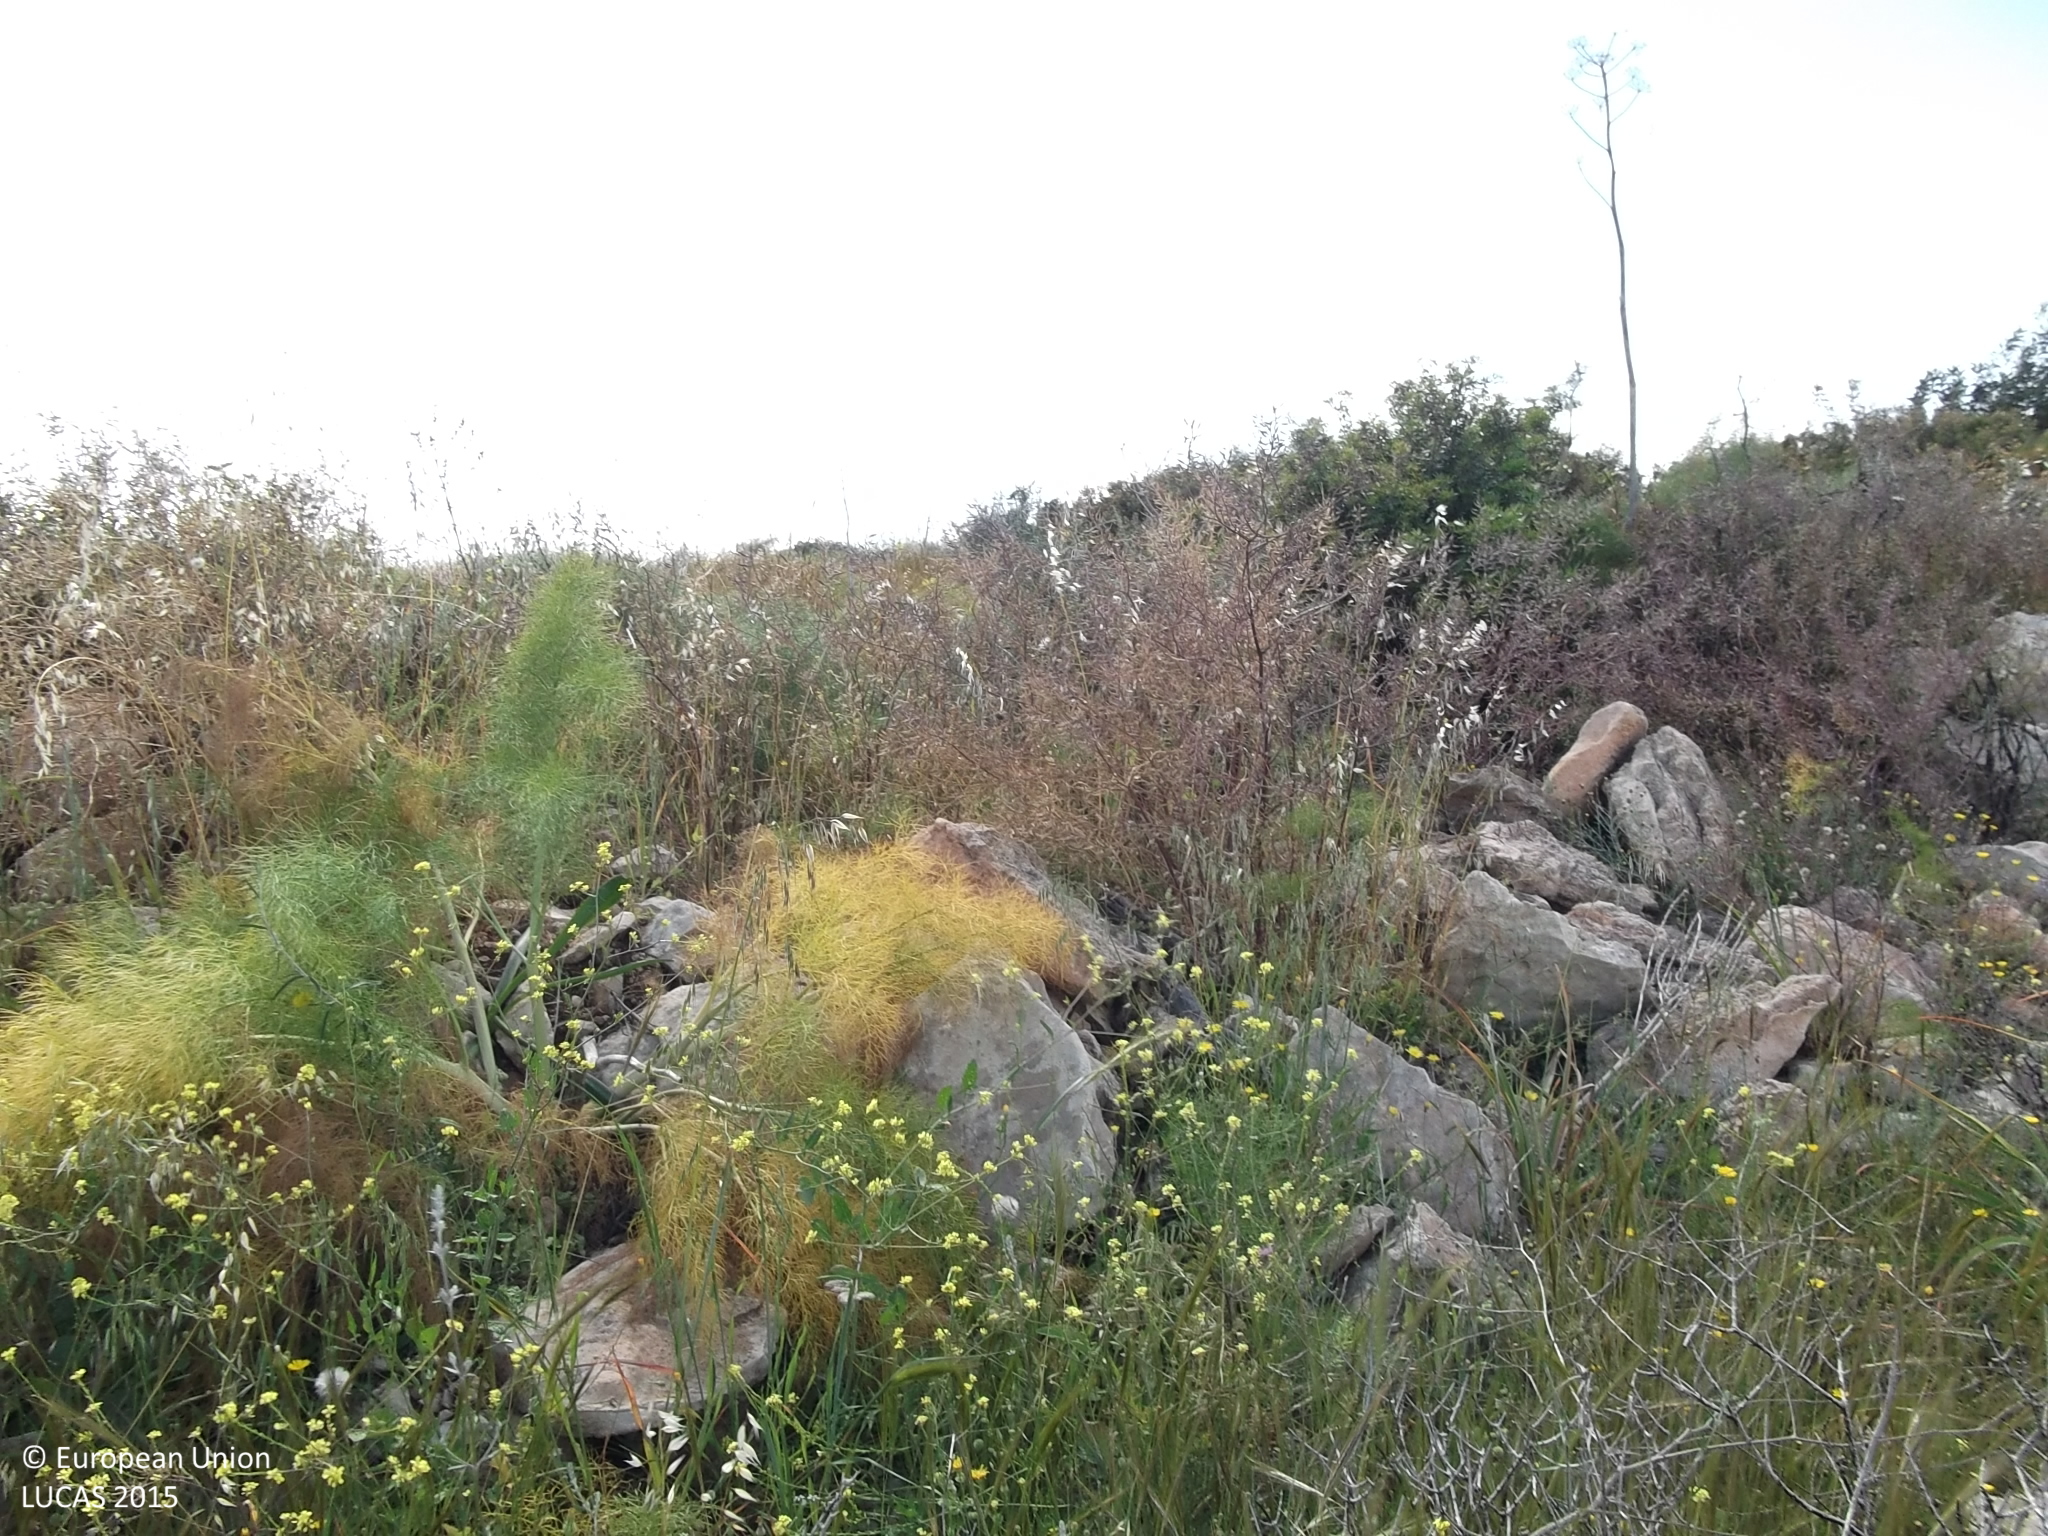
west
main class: Shrubland
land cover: Shrubland without tree cover
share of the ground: 50 - 75 %
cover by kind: shrubs 70 %, herbaceous plants 30 %
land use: Semi-natural and natural areas not in use
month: April
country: CY
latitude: 34.7779
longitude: 33.4256
